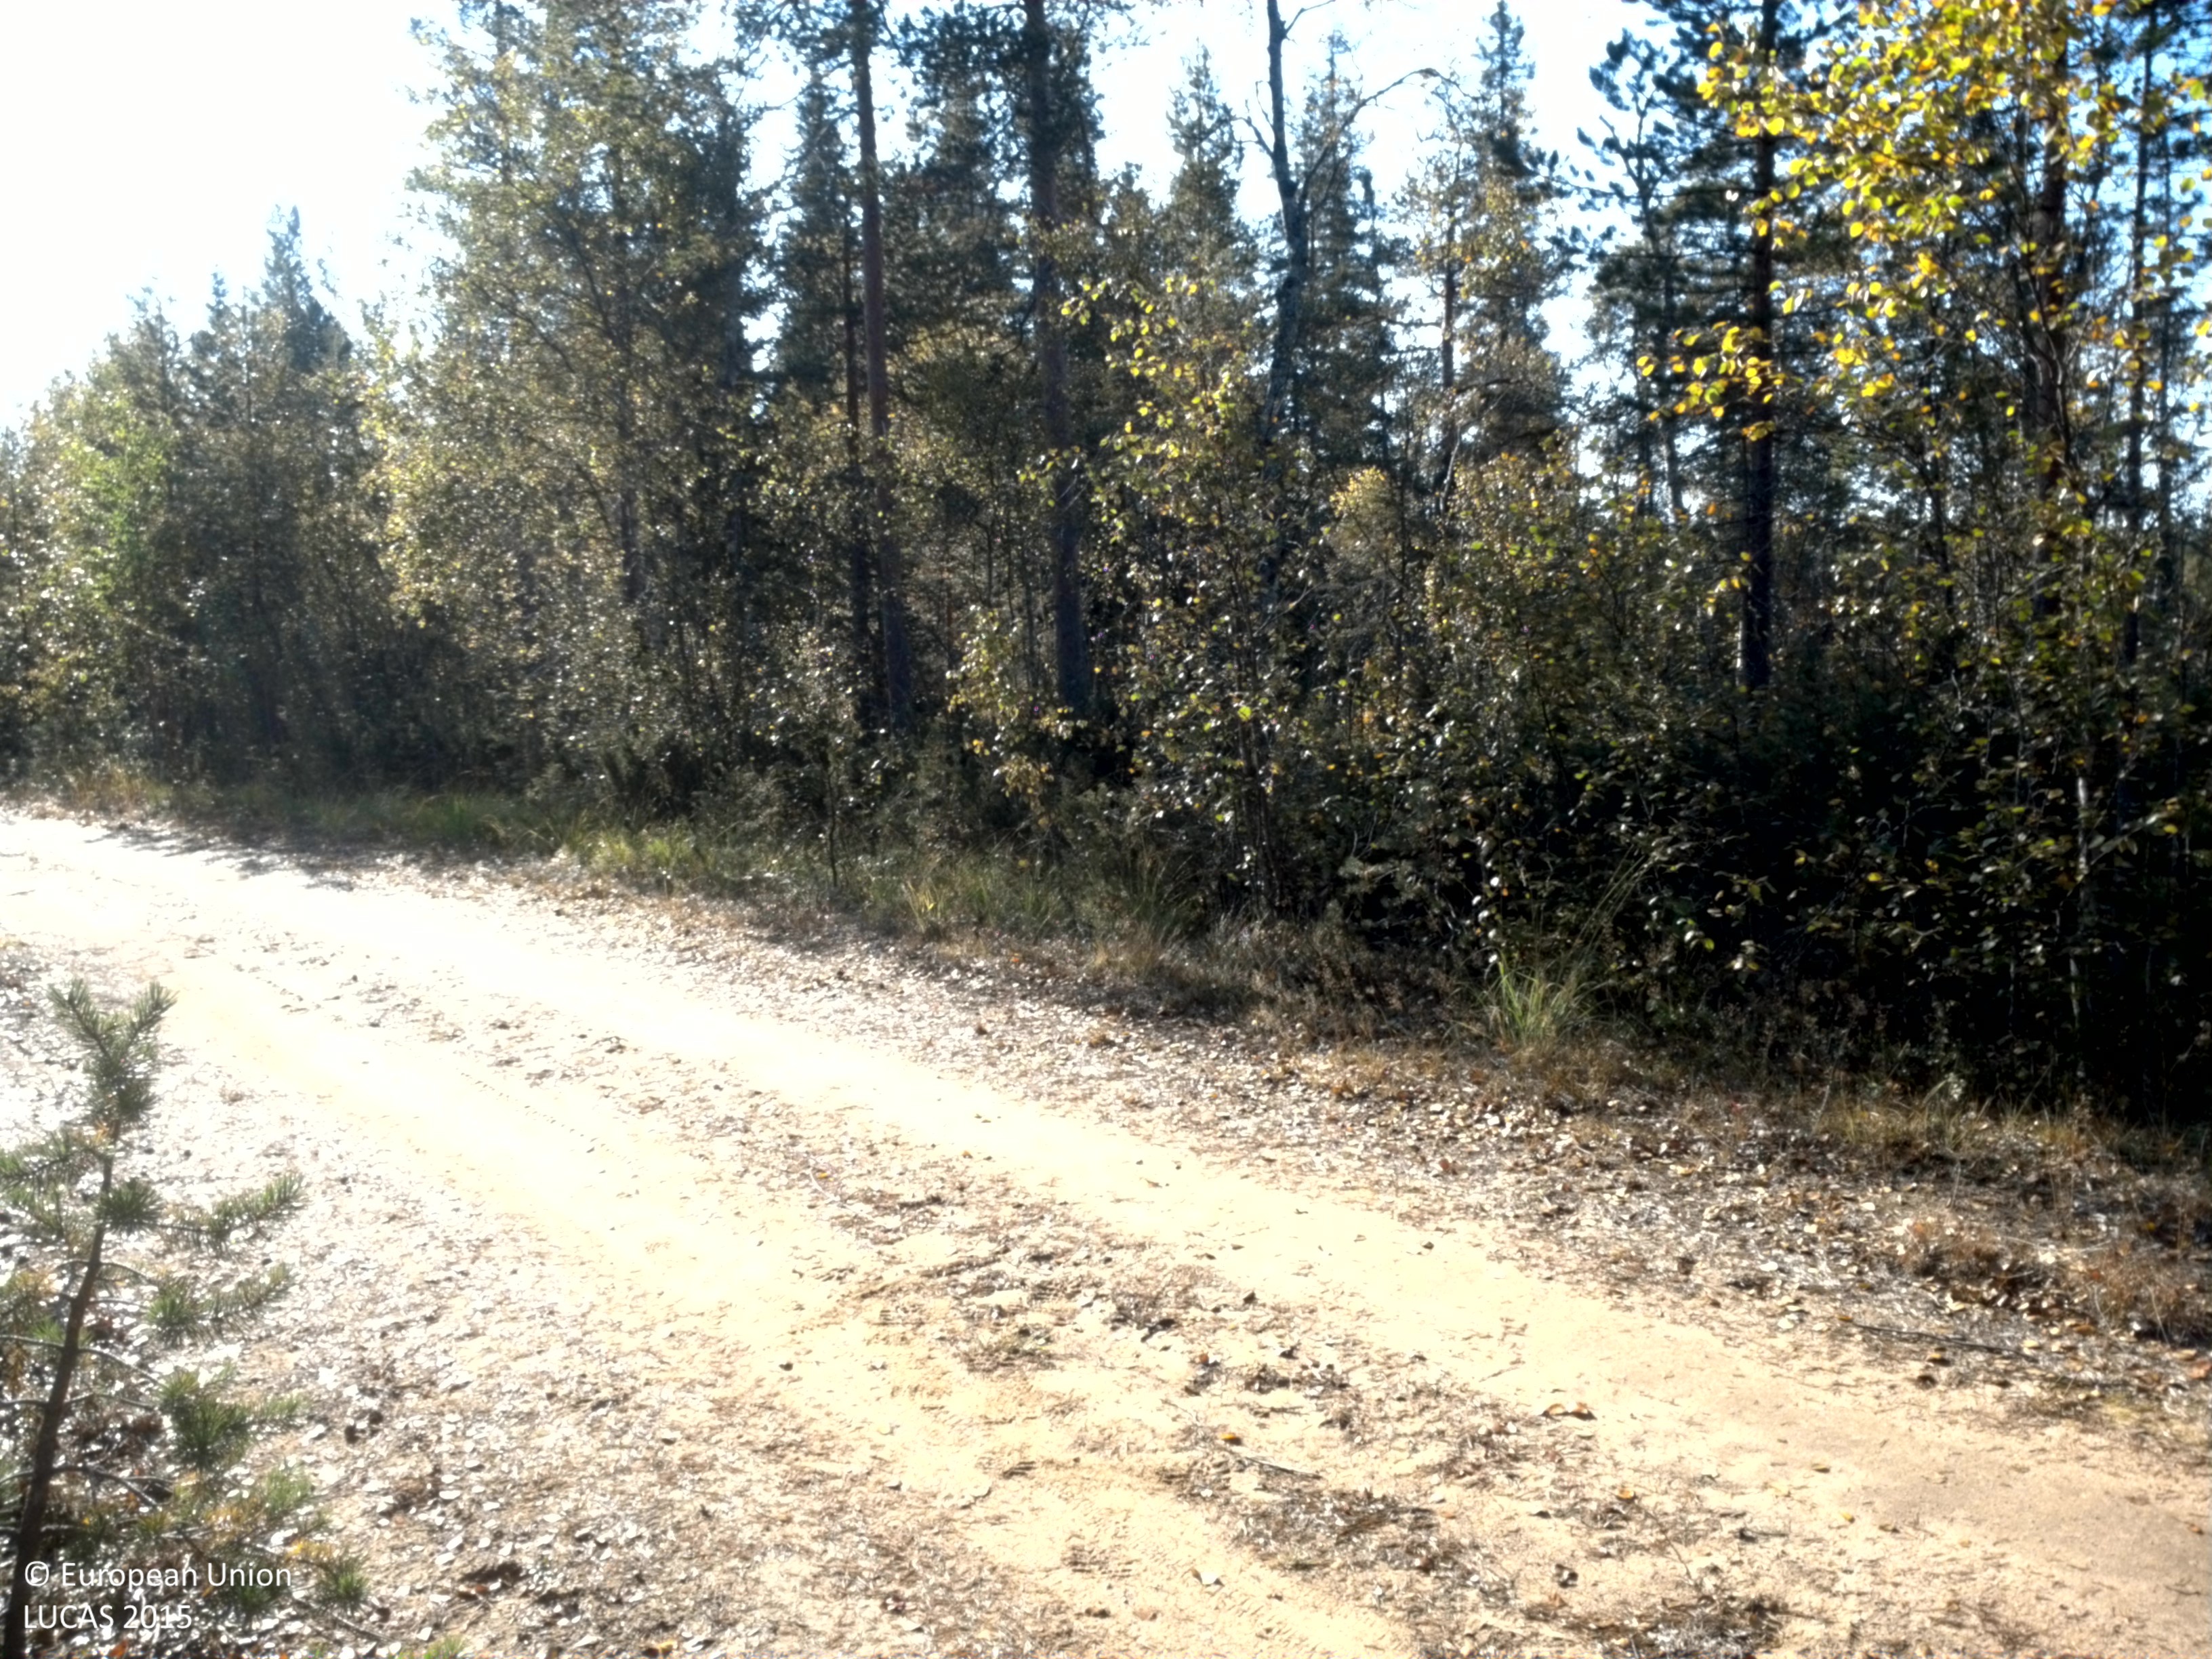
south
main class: Woodland
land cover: Pine dominated mixed woodland
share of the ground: 25 - 50 %
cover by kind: shrubs 60 %, coniferous forest trees 20 %, broadleaved forest trees 20 %
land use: Forestry
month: September
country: SE
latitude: 65.8976
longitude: 22.5548
